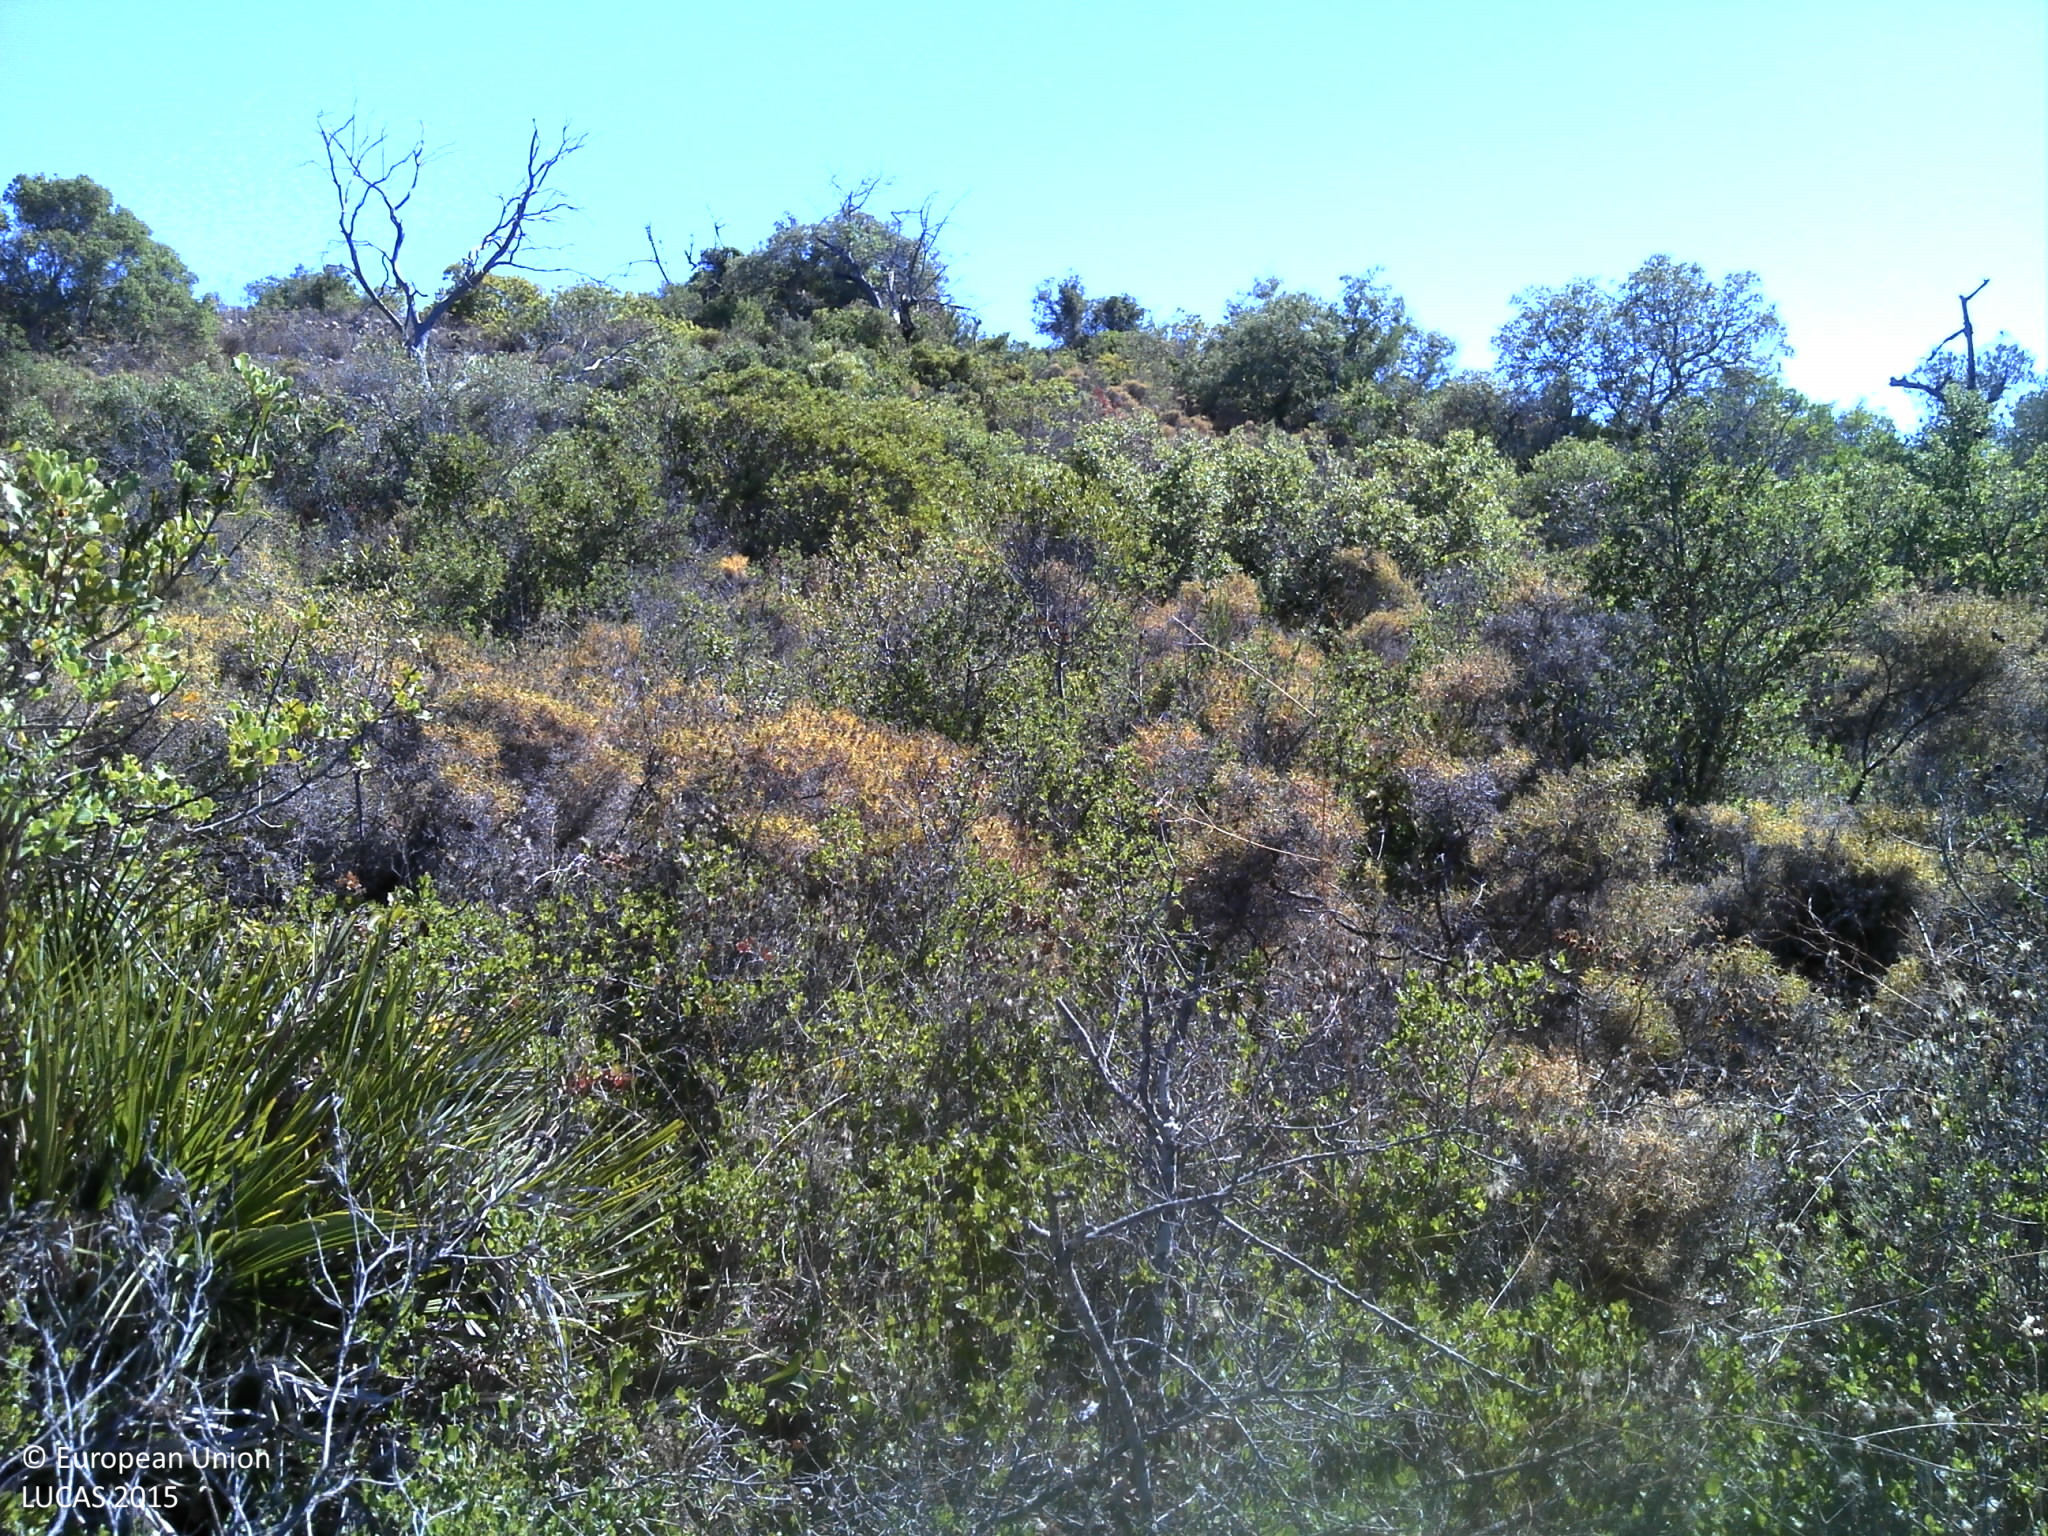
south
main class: Shrubland
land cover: Shrubland with sparse tree cover
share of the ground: 50 - 75 %
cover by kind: shrubs 70 %, unconsolidated bare surface 25 %, broadleaved forest trees 5 %
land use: Abandoned areas
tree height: < 5 m
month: September
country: PT
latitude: 37.1686
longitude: -8.1600
